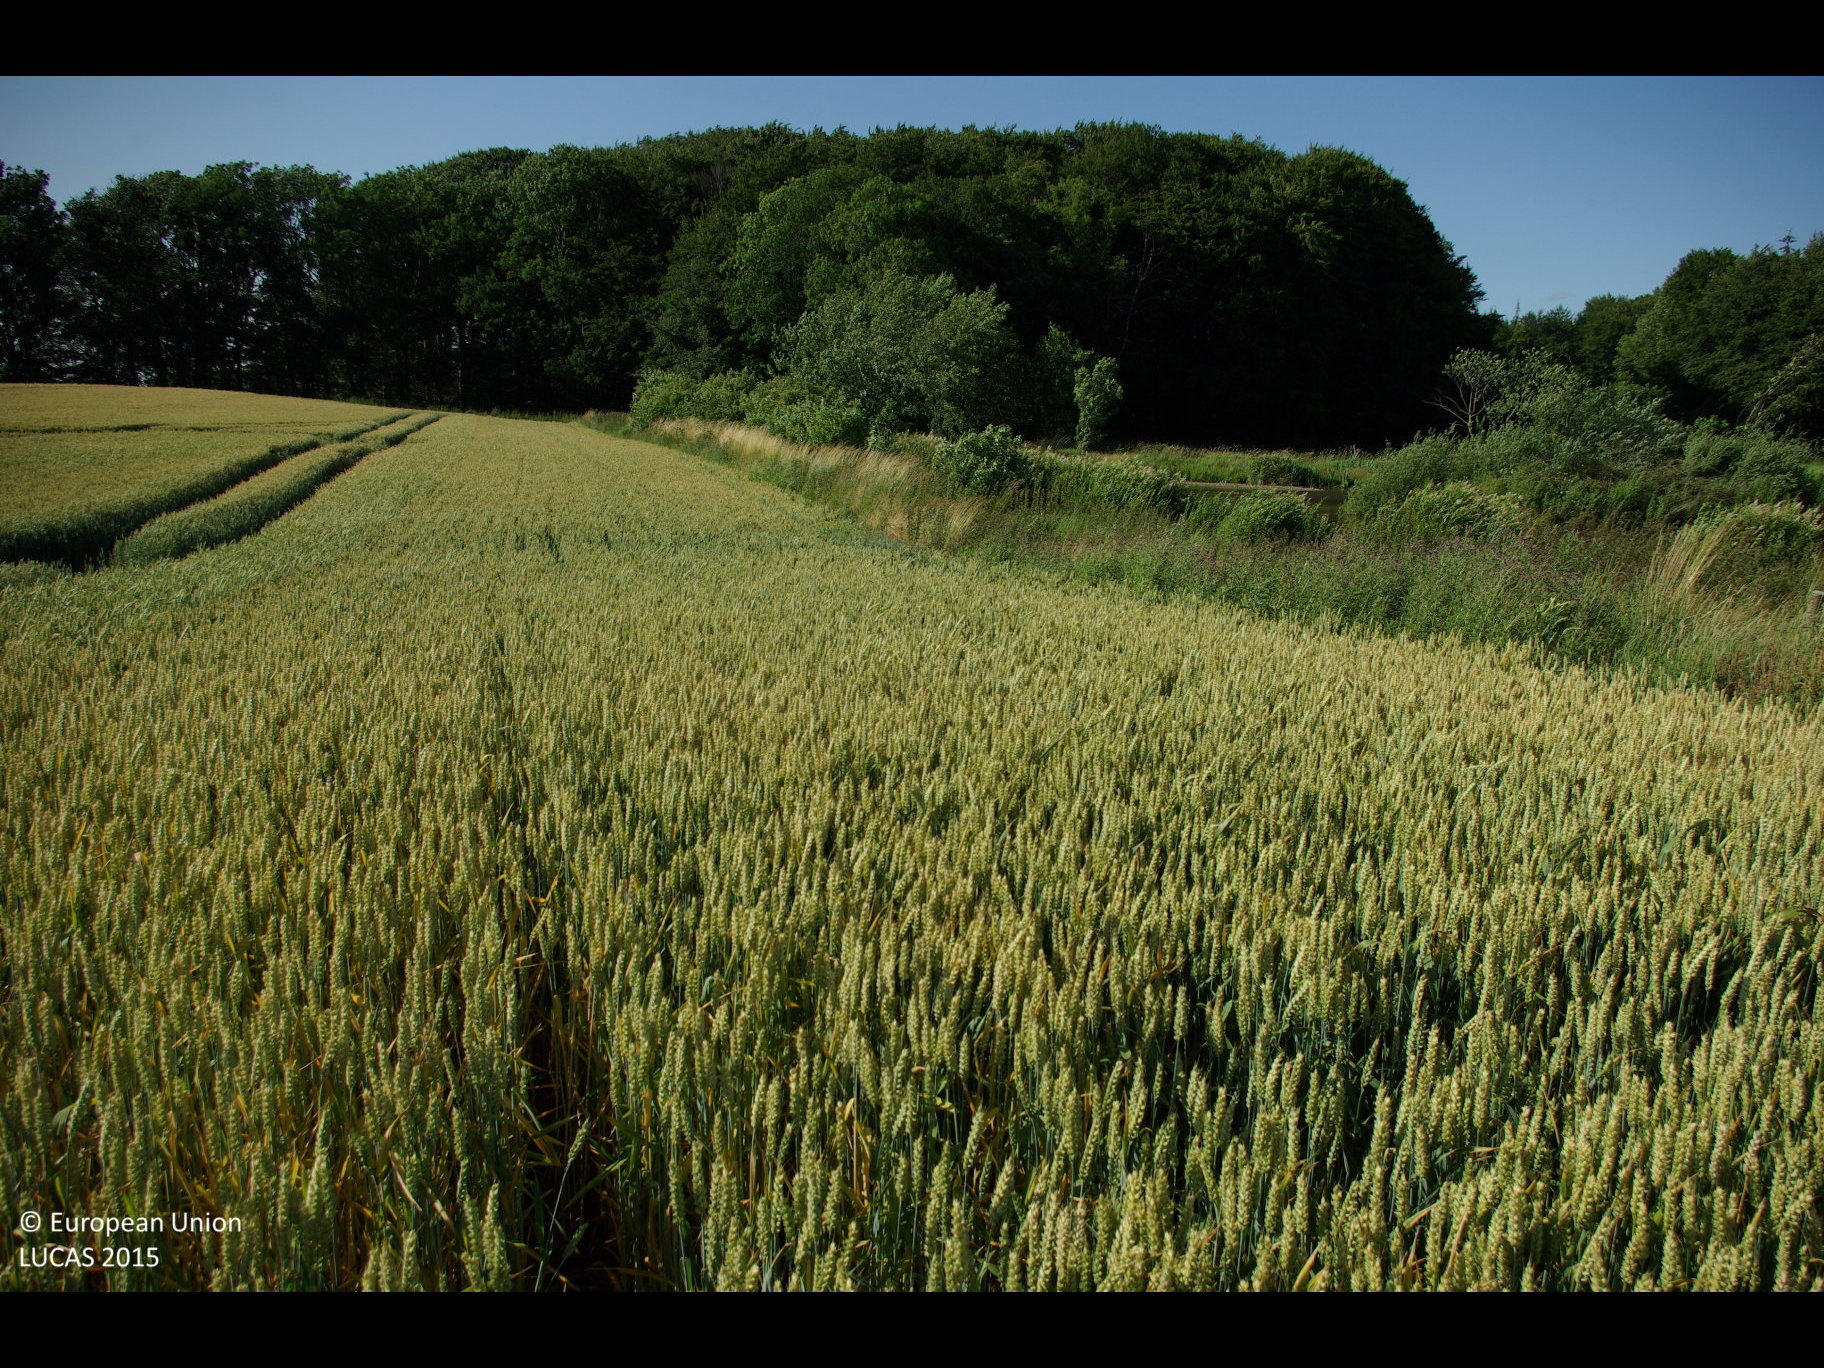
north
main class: Cropland
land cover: Common wheat
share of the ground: > 75 %
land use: Agriculture (excluding fallow land and kitchen gardens)
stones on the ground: 10 - 25 %
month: July
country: DE
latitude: 54.6599
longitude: 9.8606
